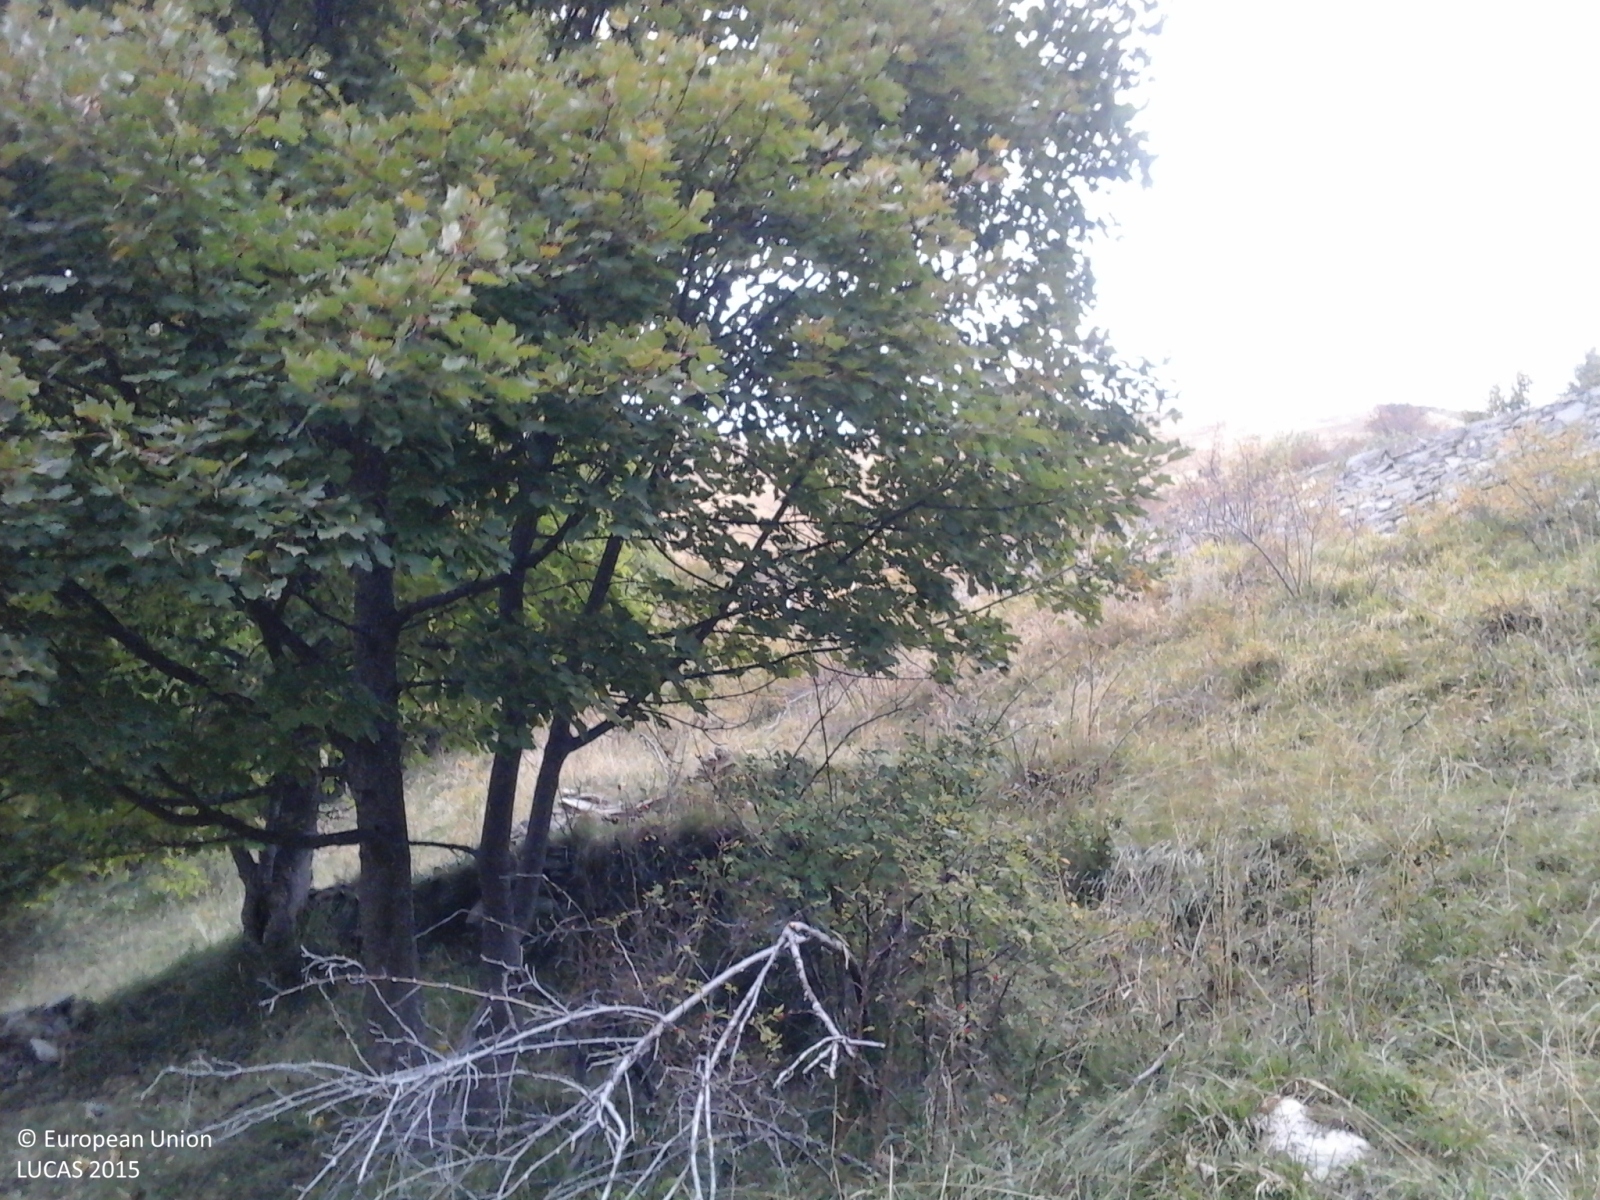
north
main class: Grassland
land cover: Grassland without tree/shrub cover
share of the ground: > 75 %
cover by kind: herbaceous plants 90 %, consolidated bare surface 10 %
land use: Agriculture (excluding fallow land and kitchen gardens)
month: October
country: IT
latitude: 44.0560
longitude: 7.7708
